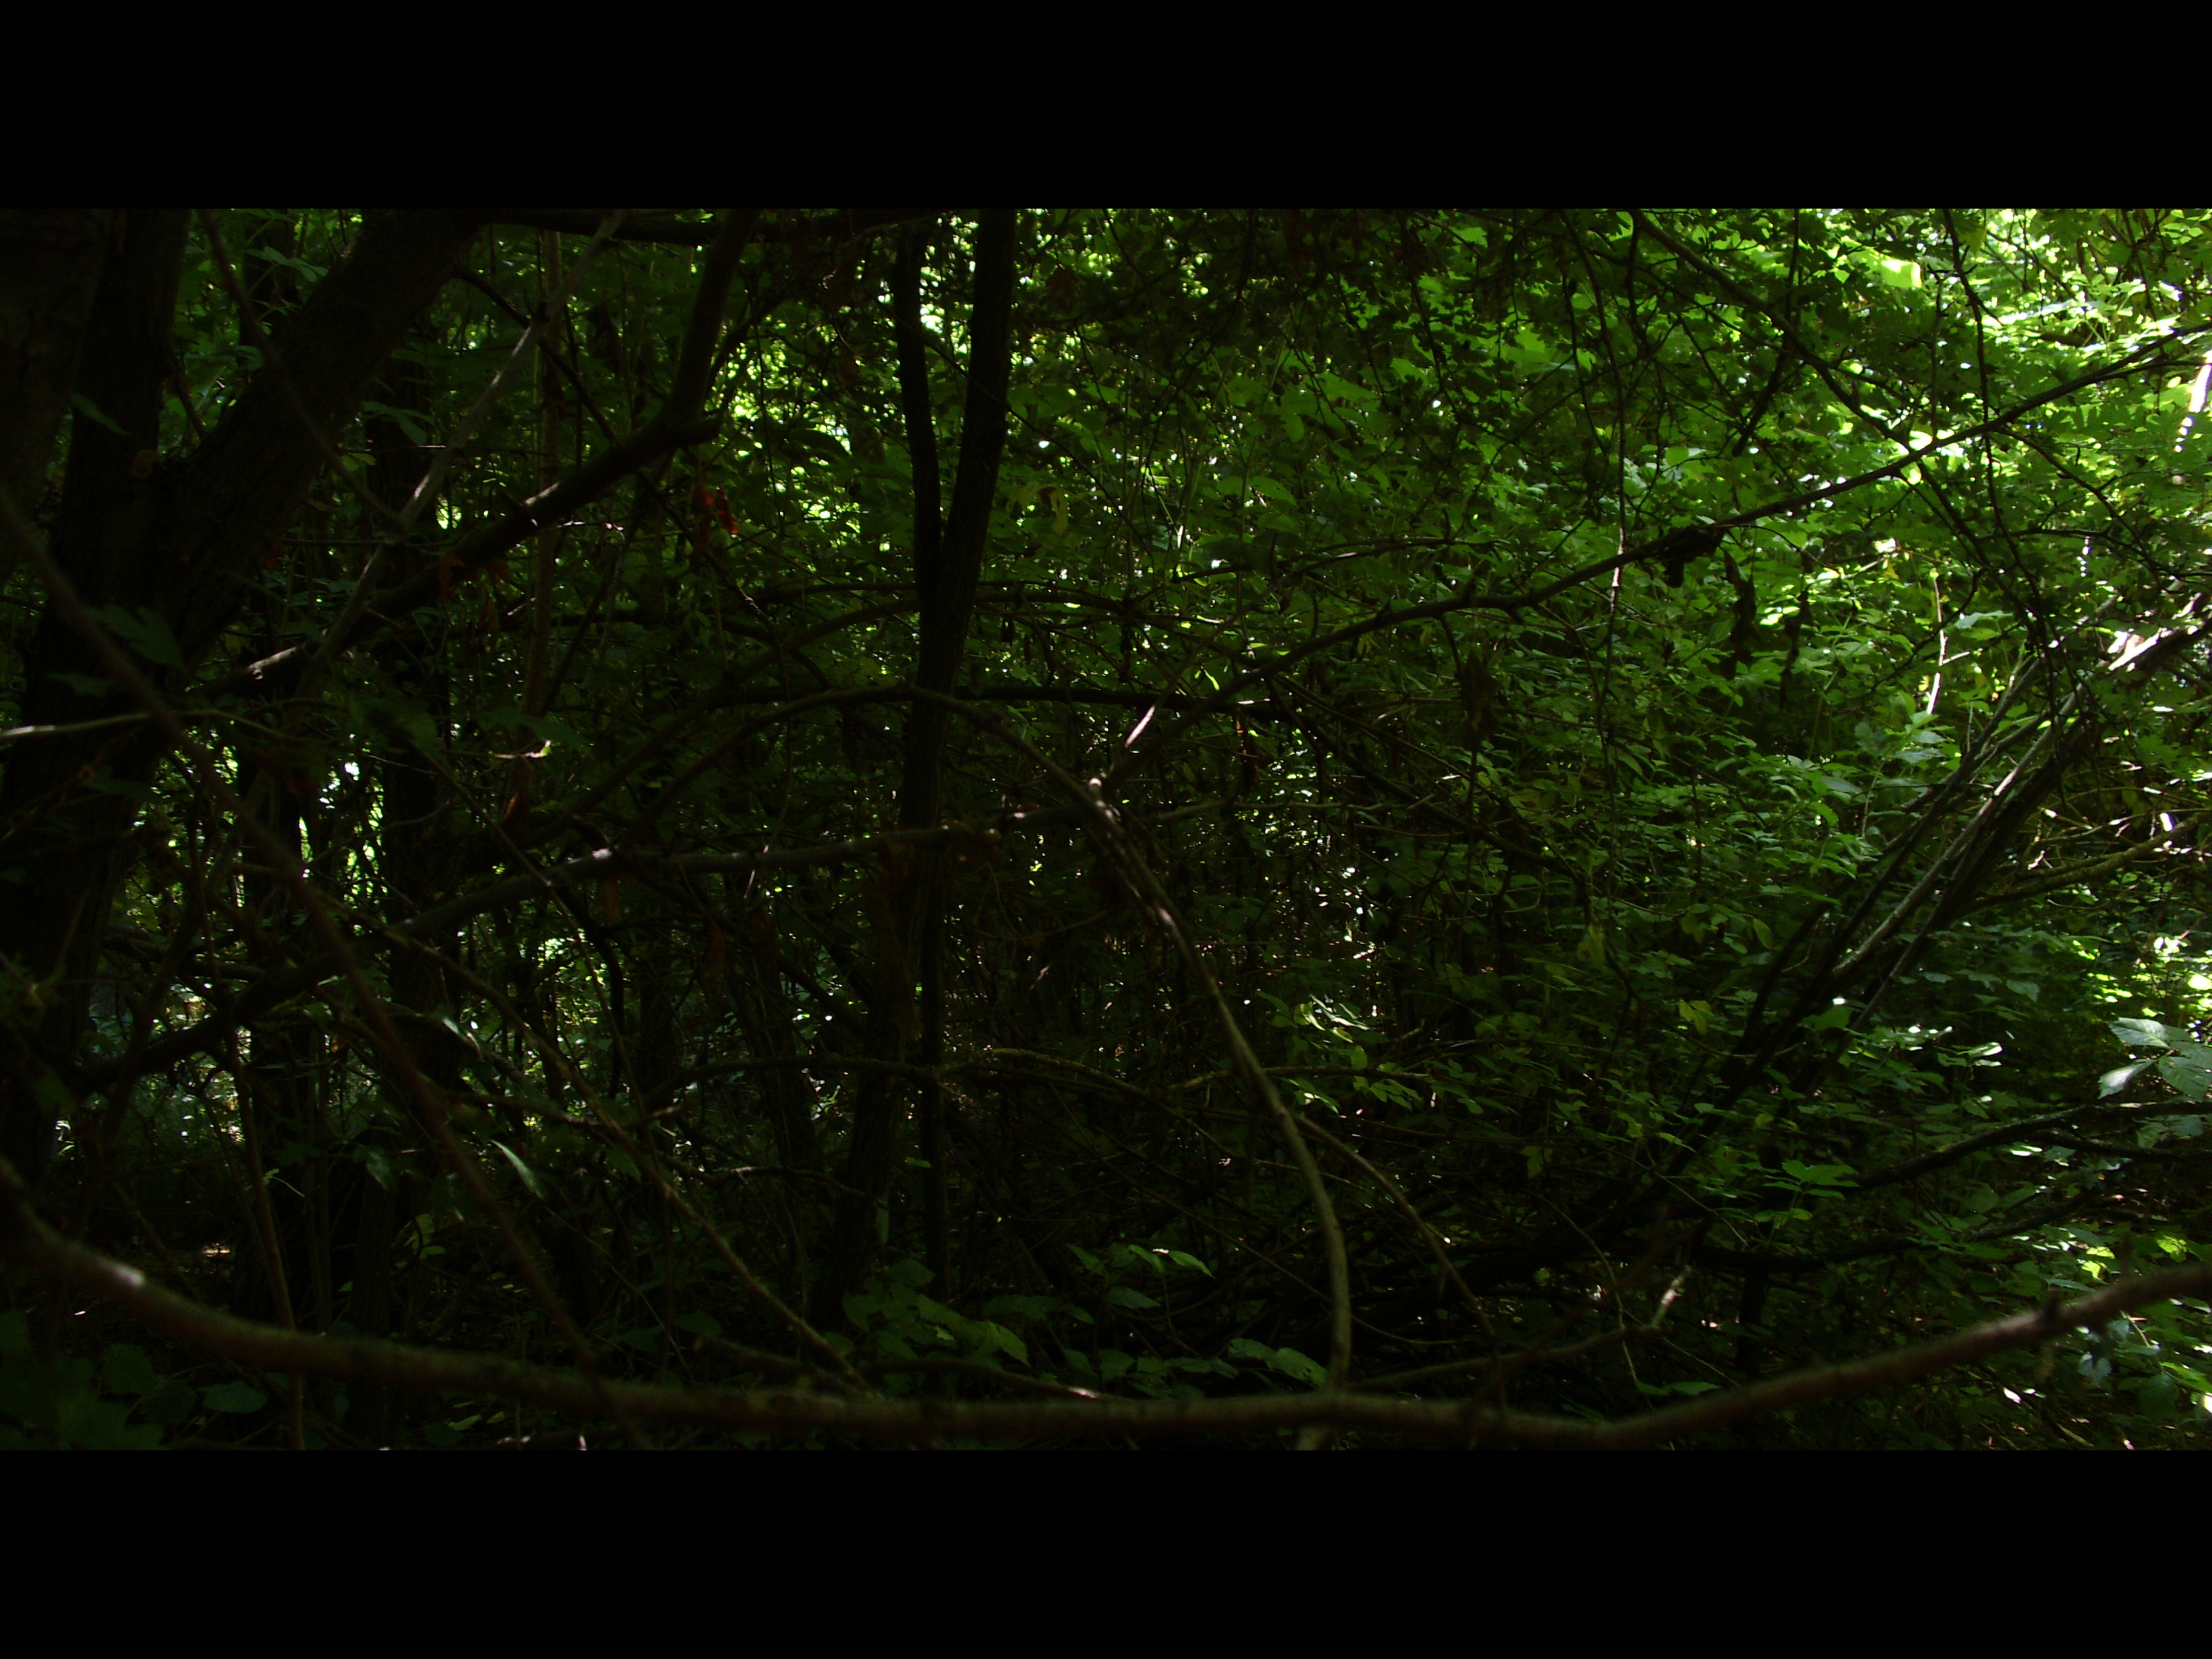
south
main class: Woodland
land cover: Broadleaved woodland
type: mesophytic deciduous forest
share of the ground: > 75 %
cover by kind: broadleaved forest trees 95 %, shrubs 5 %
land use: Forestry
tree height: > 5 m
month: June
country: BG
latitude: 43.6207
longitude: 23.6926
